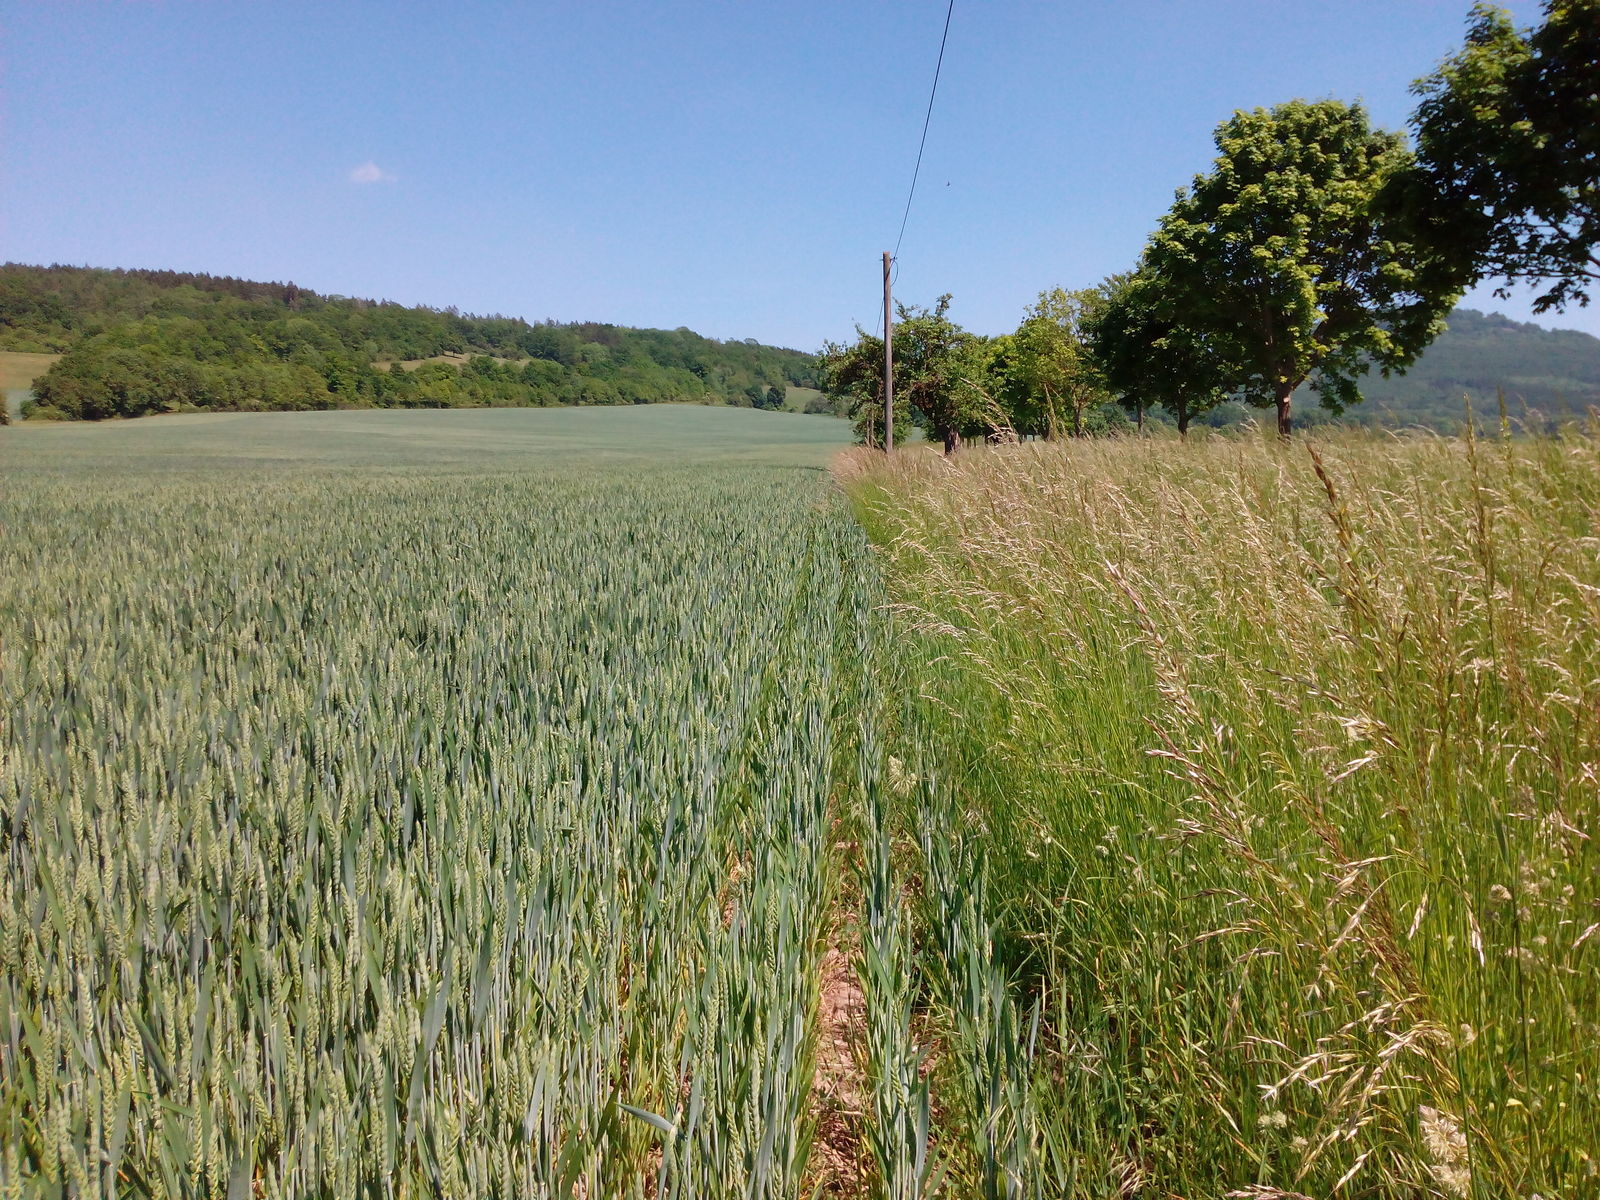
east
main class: Cropland
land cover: Common wheat
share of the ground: > 75 %
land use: Agriculture (excluding fallow land and kitchen gardens)
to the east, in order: Common wheat
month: June
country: DE
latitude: 50.4167
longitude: 10.5487
